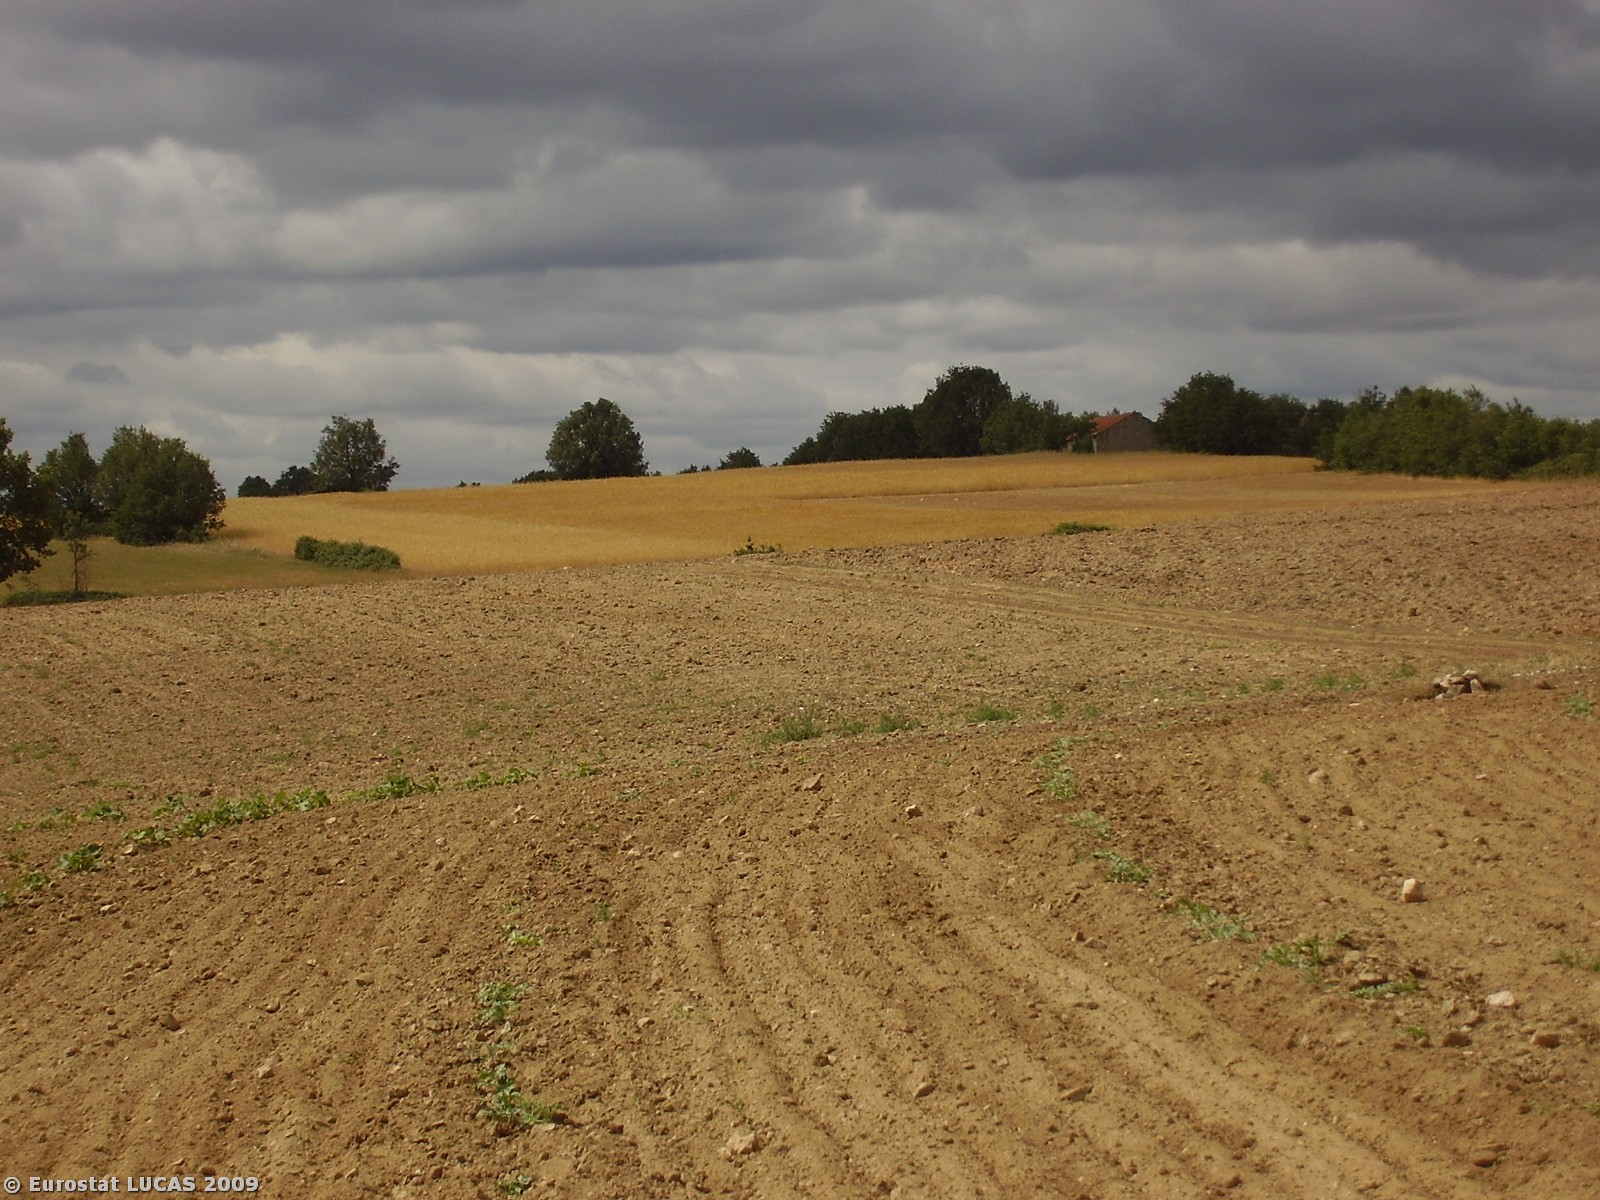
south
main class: Cropland
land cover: Other fresh vegetables
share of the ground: < 10 %
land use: Agriculture (excluding fallow land and kitchen gardens)
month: June
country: PT
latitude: 41.5371
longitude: -6.3411
